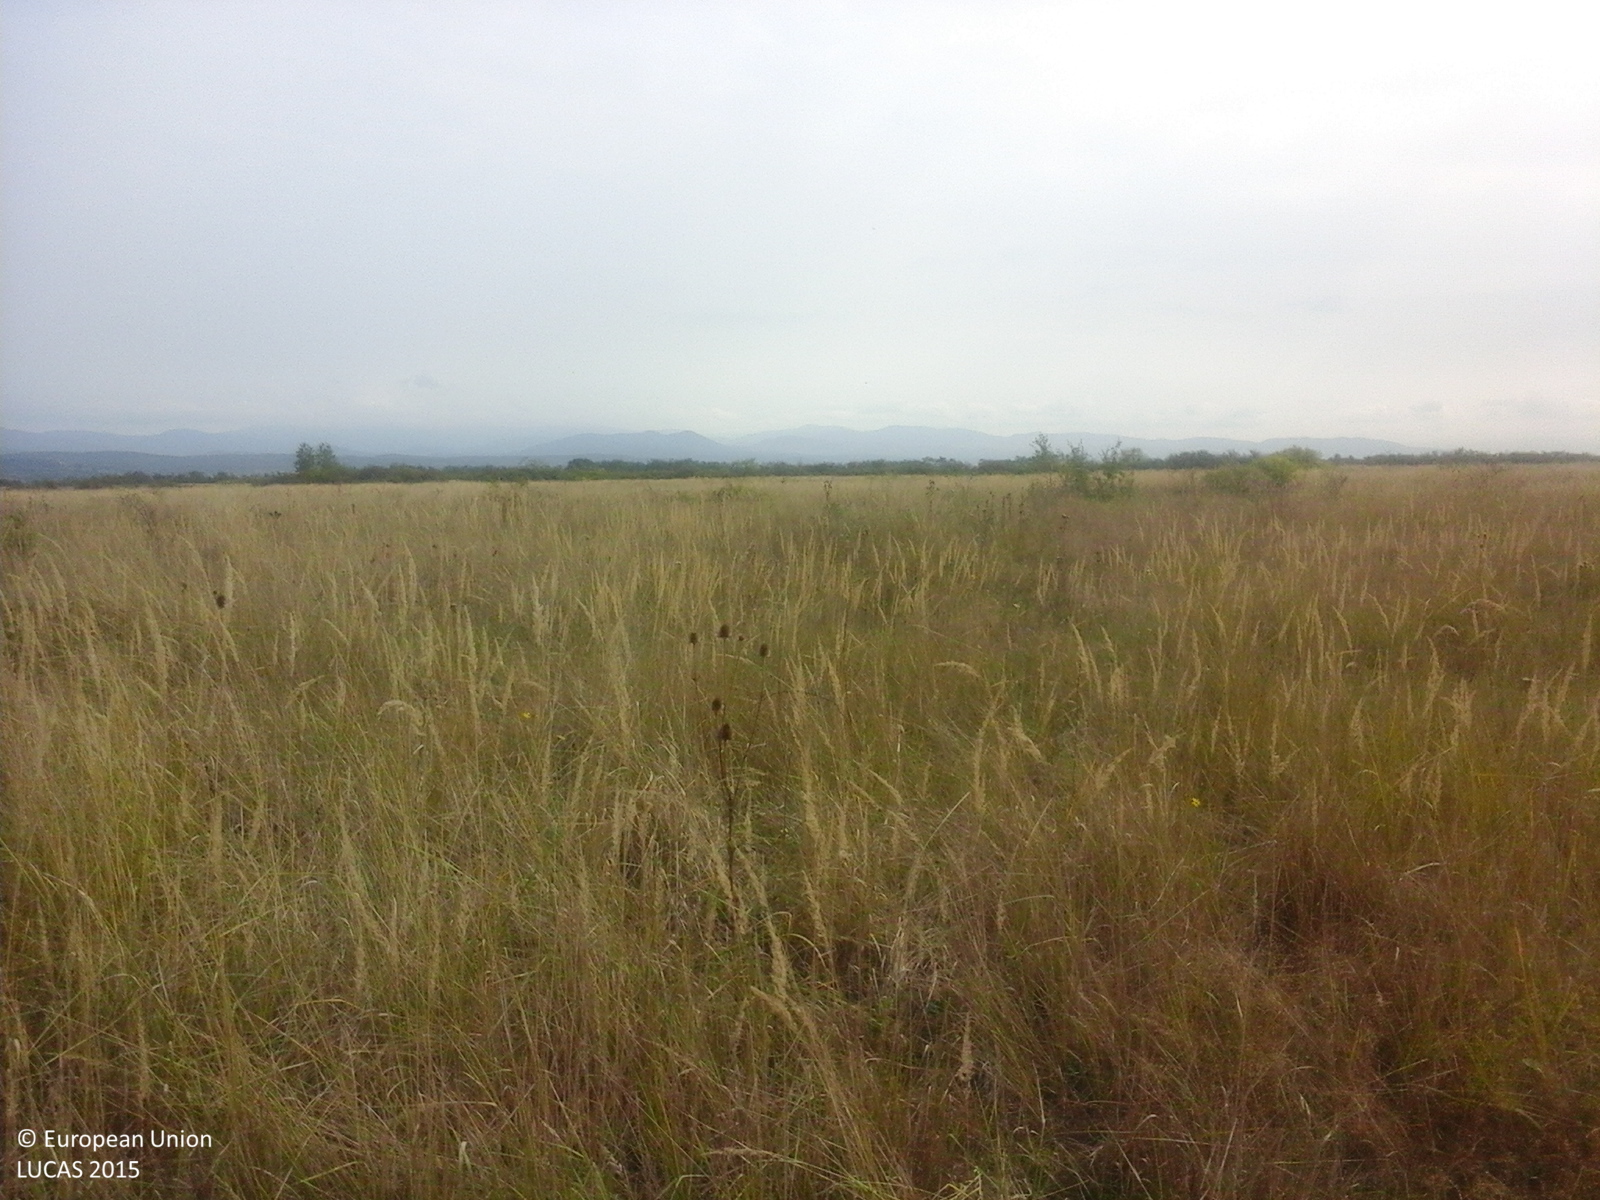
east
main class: Grassland
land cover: Spontaneously vegetated surfaces
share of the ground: > 75 %
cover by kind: herbaceous plants 100 %
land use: Fallow land
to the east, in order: Spontaneously vegetated surfaces; Abandoned hedges
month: September
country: RO
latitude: 45.6413
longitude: 21.9577
